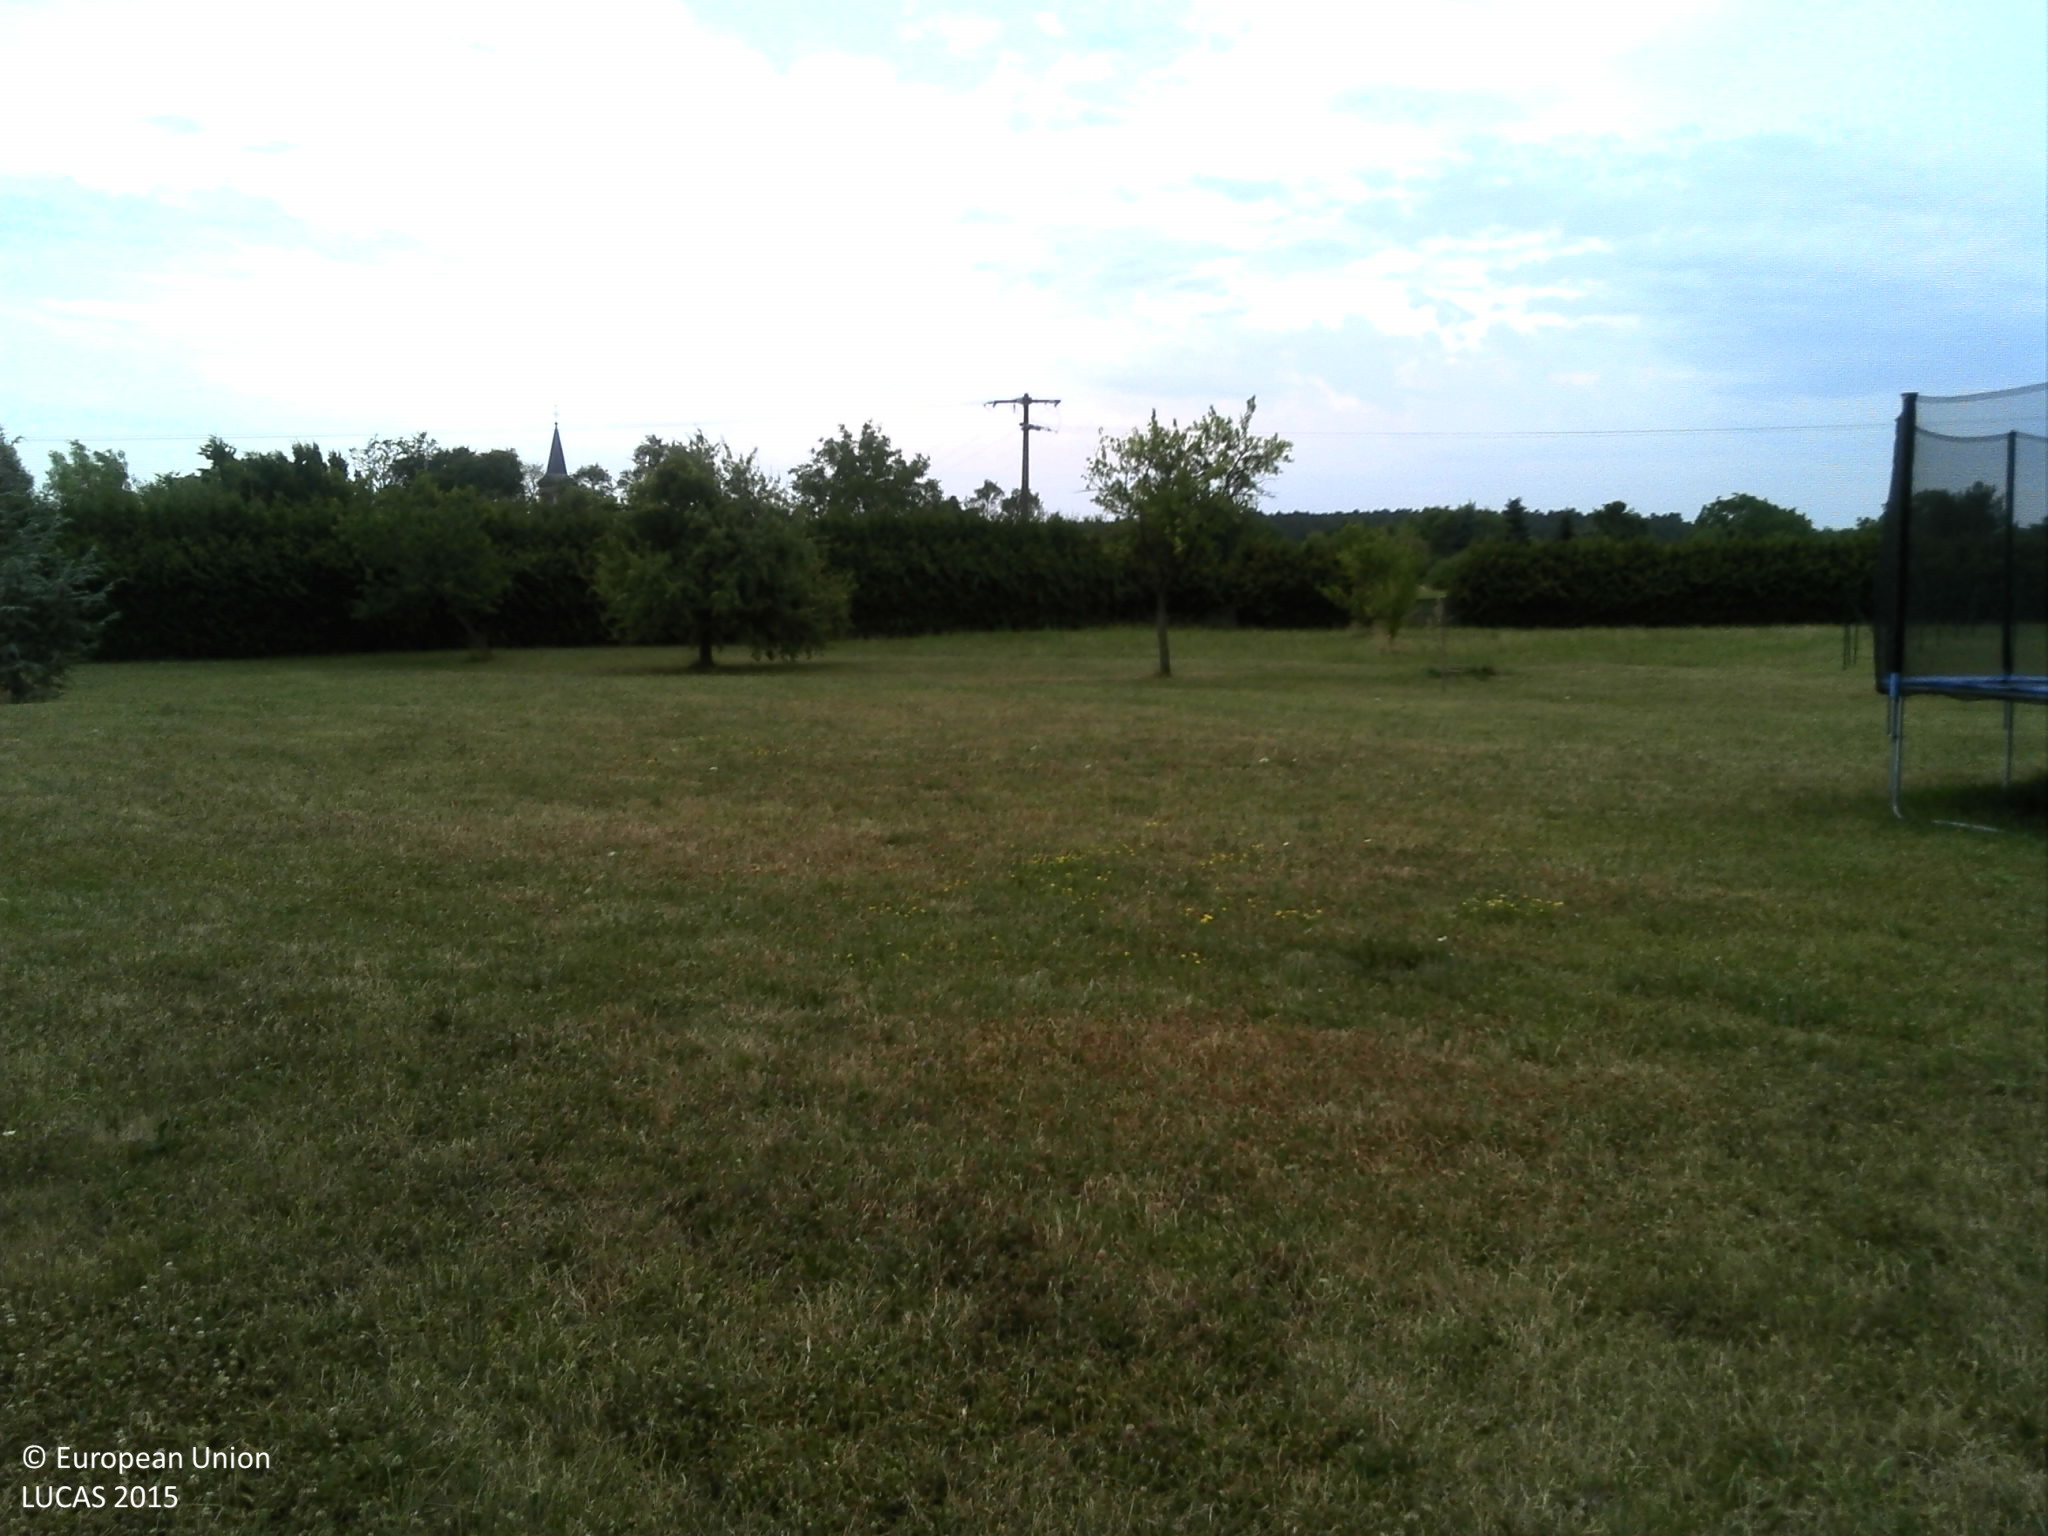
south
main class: Grassland
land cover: Grassland without tree/shrub cover
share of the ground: > 75 %
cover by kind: herbaceous plants 100 %
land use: Residential
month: July
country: FR
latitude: 49.4100
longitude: 6.4853
